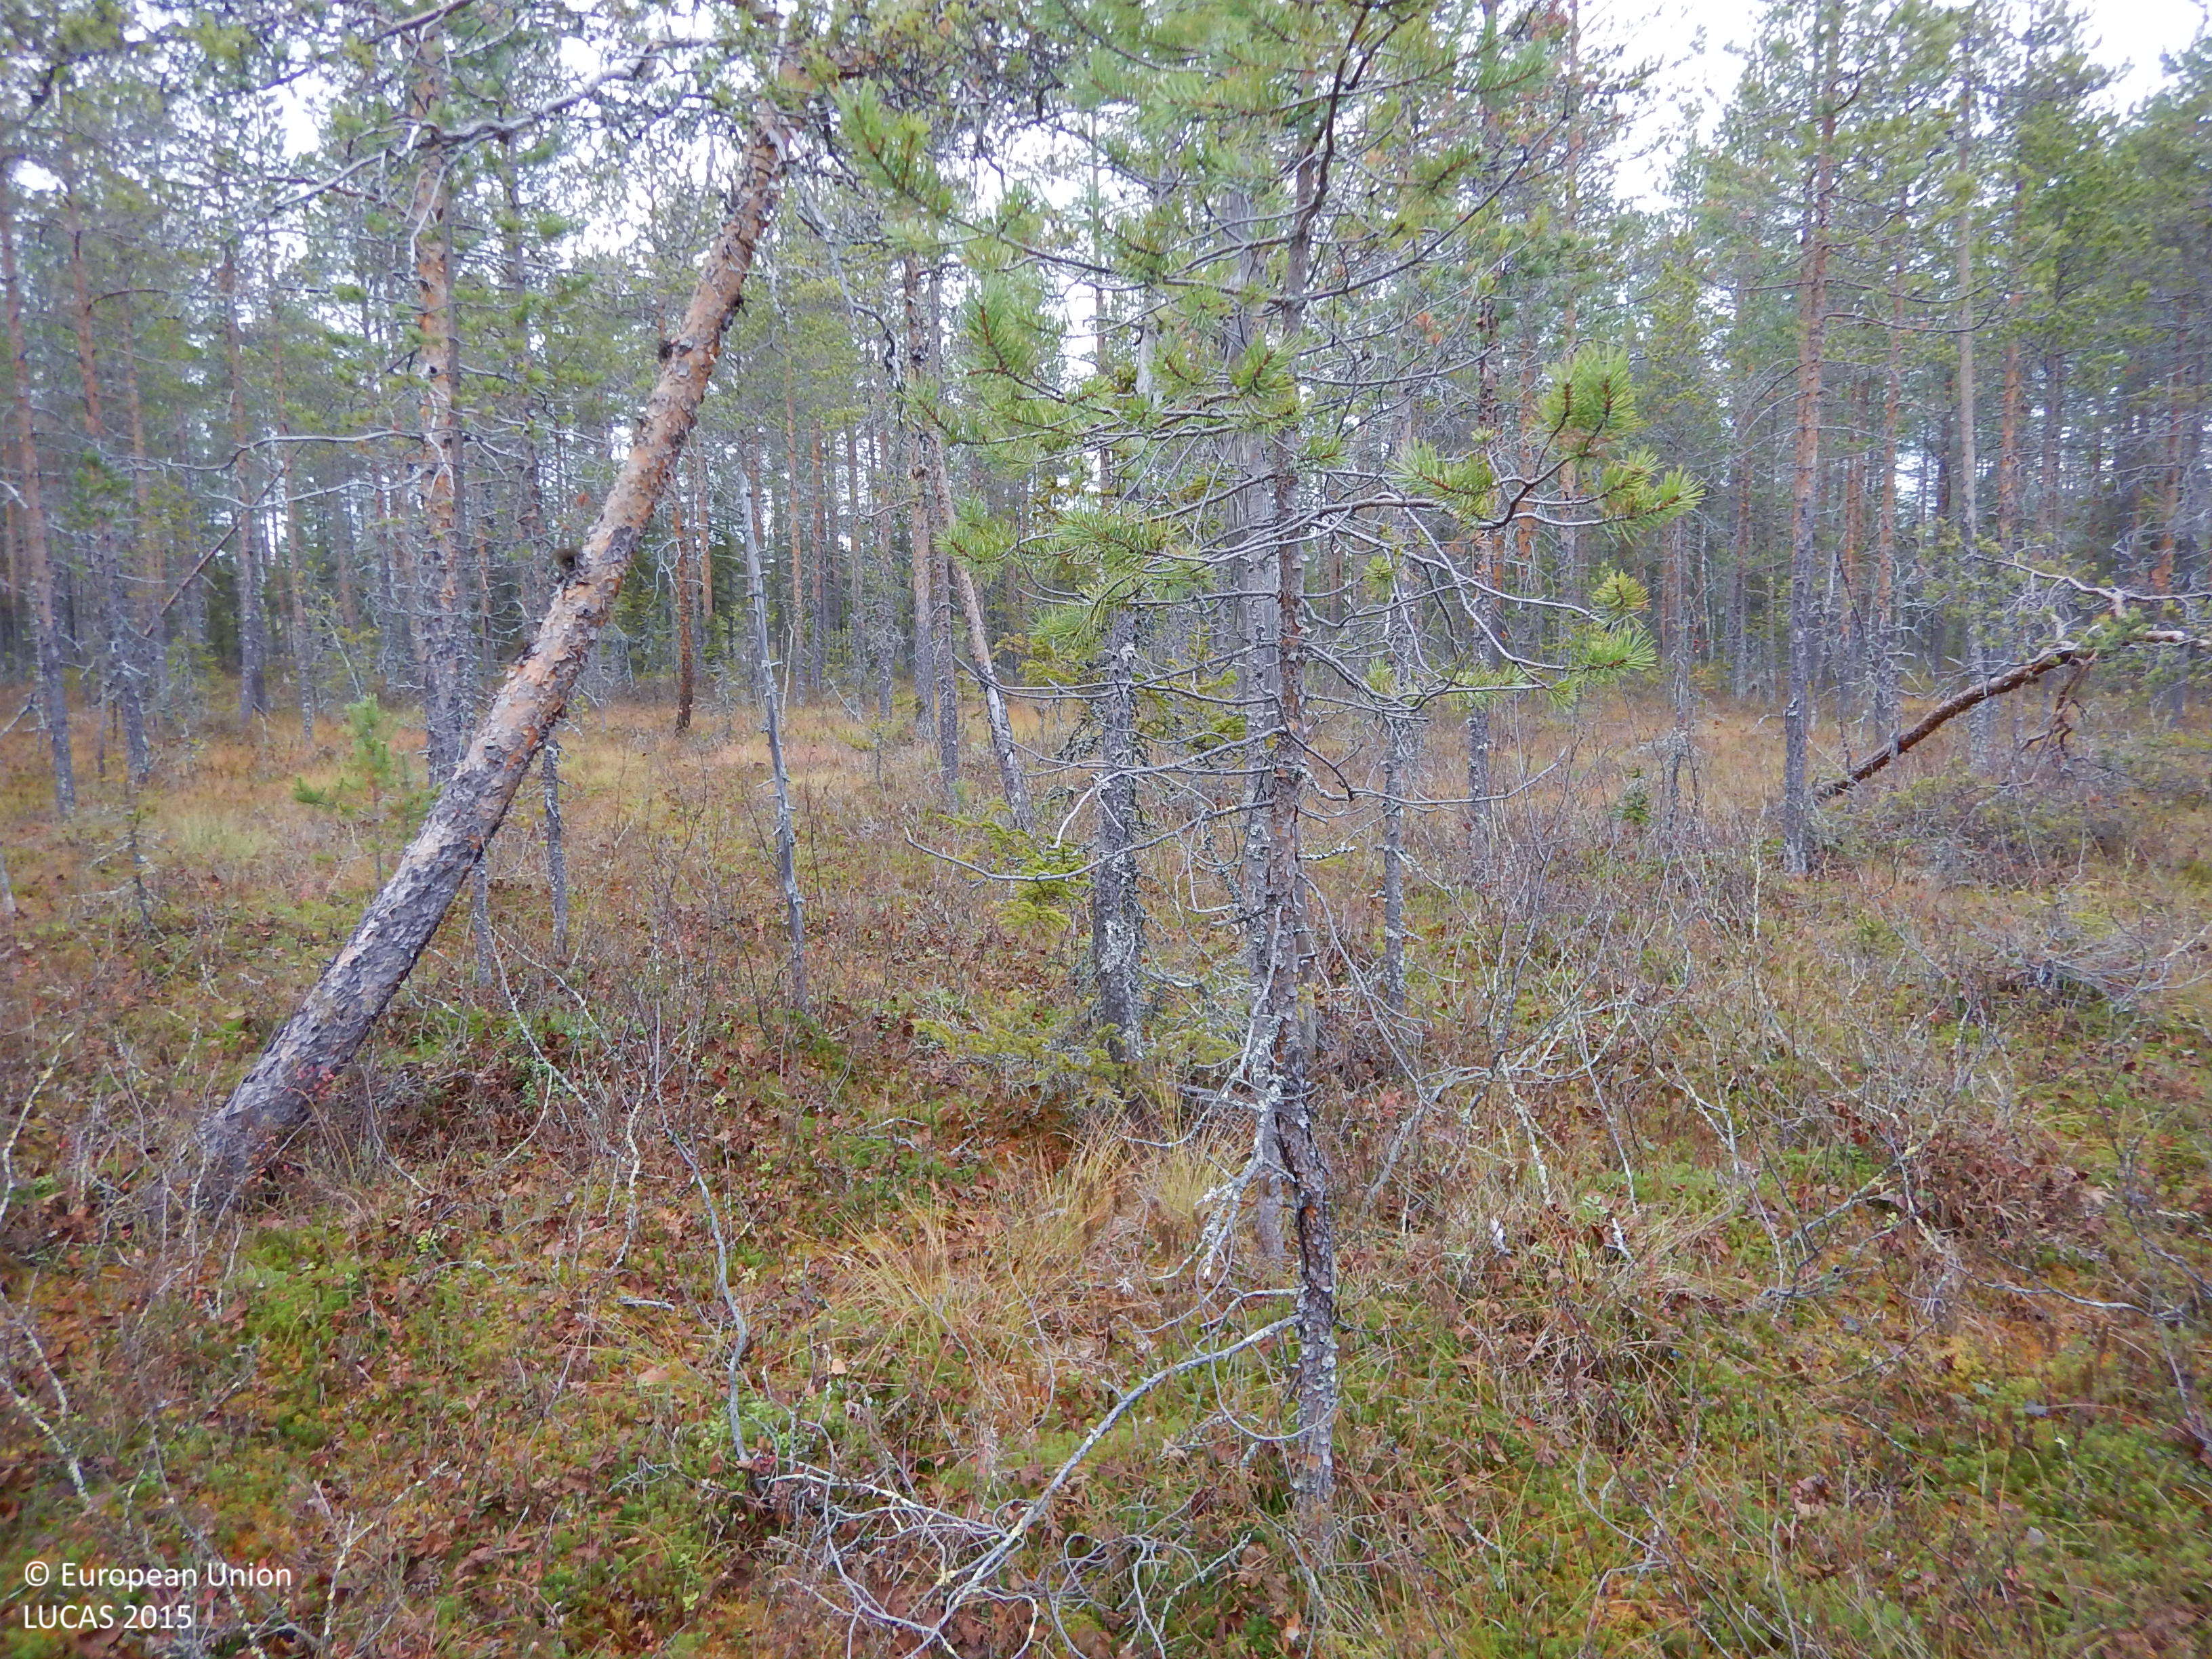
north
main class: Woodland
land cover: Pine dominated coniferous woodland
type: mire and swamp forests
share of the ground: 25 - 50 %
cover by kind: coniferous forest trees 40 %, lichens and mosses 30 %, shrubs 20 %, herbaceous plants 10 %
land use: Semi-natural and natural areas not in use
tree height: > 5 m
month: October
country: SE
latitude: 65.1010
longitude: 21.1515
